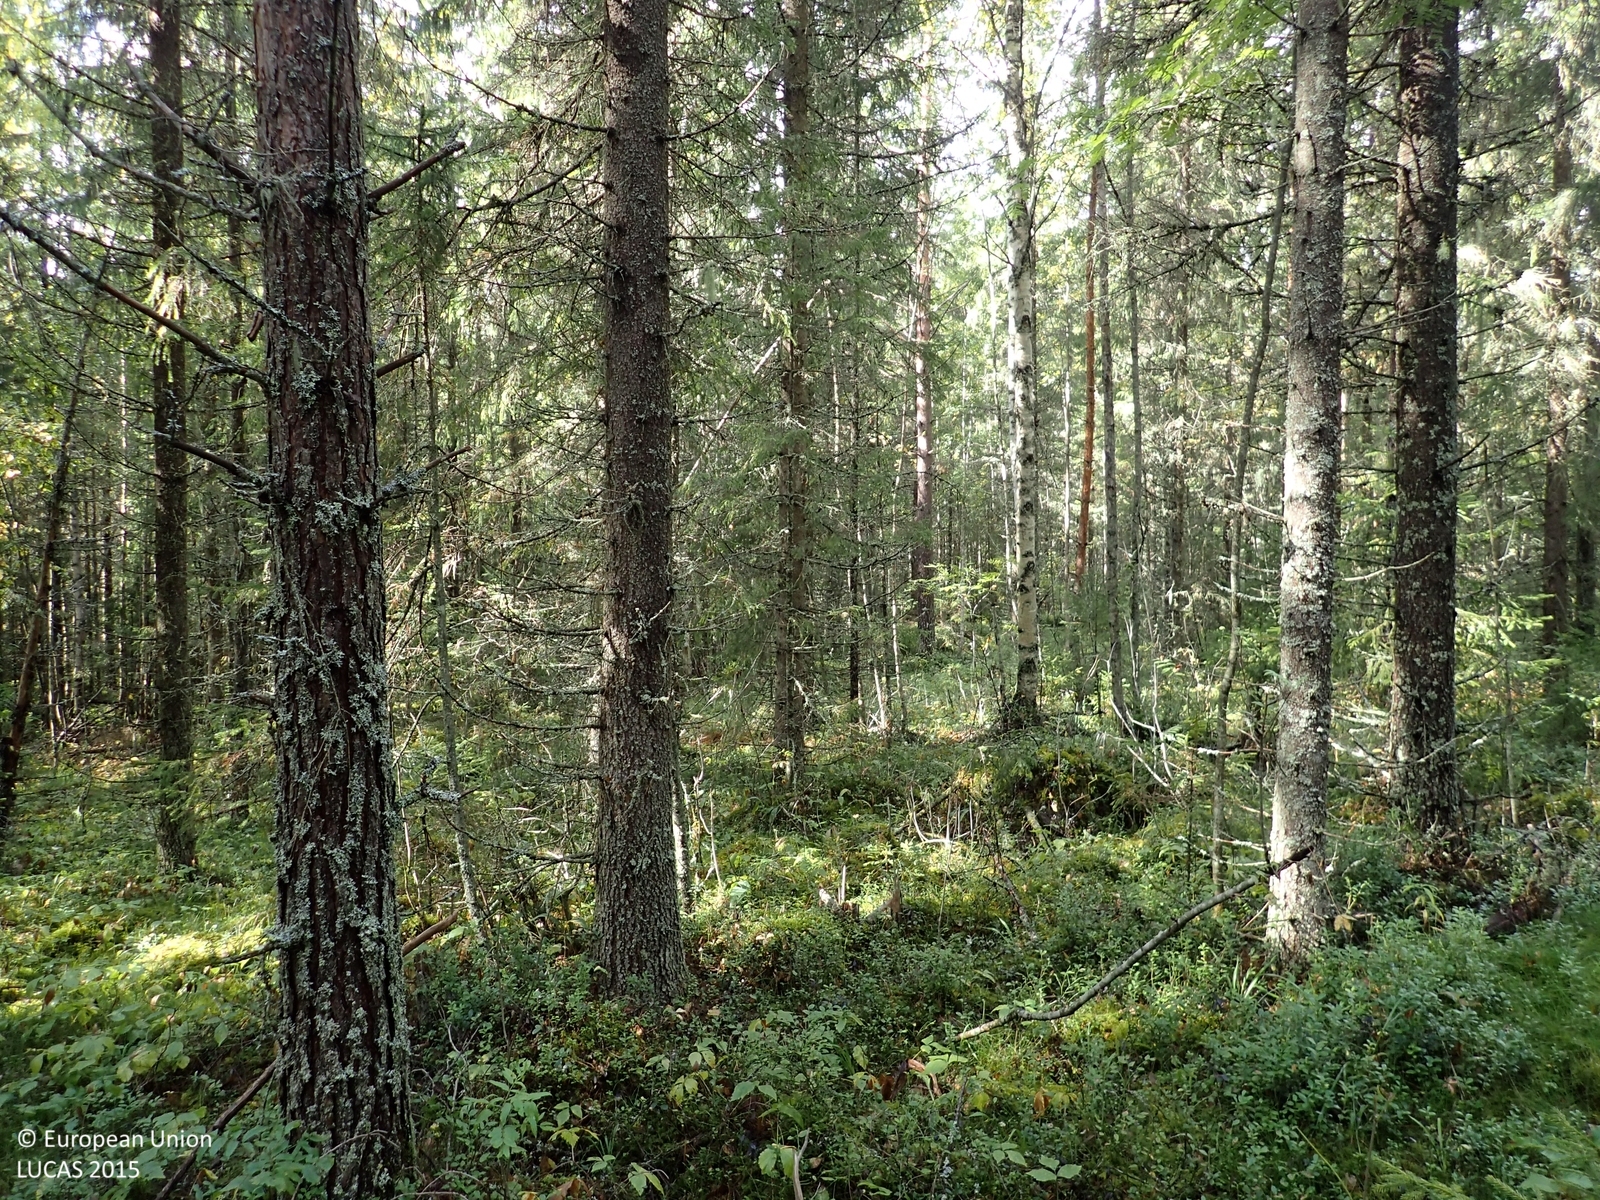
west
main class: Woodland
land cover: Spruce dominated mixed woodland
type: boreal forest
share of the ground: > 75 %
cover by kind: coniferous forest trees 55 %, broadleaved forest trees 20 %, shrubs 10 %, herbaceous plants 10 %, lichens and mosses 5 %
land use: Forestry
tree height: > 5 m
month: September
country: FI
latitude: 63.1890
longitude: 25.8316
